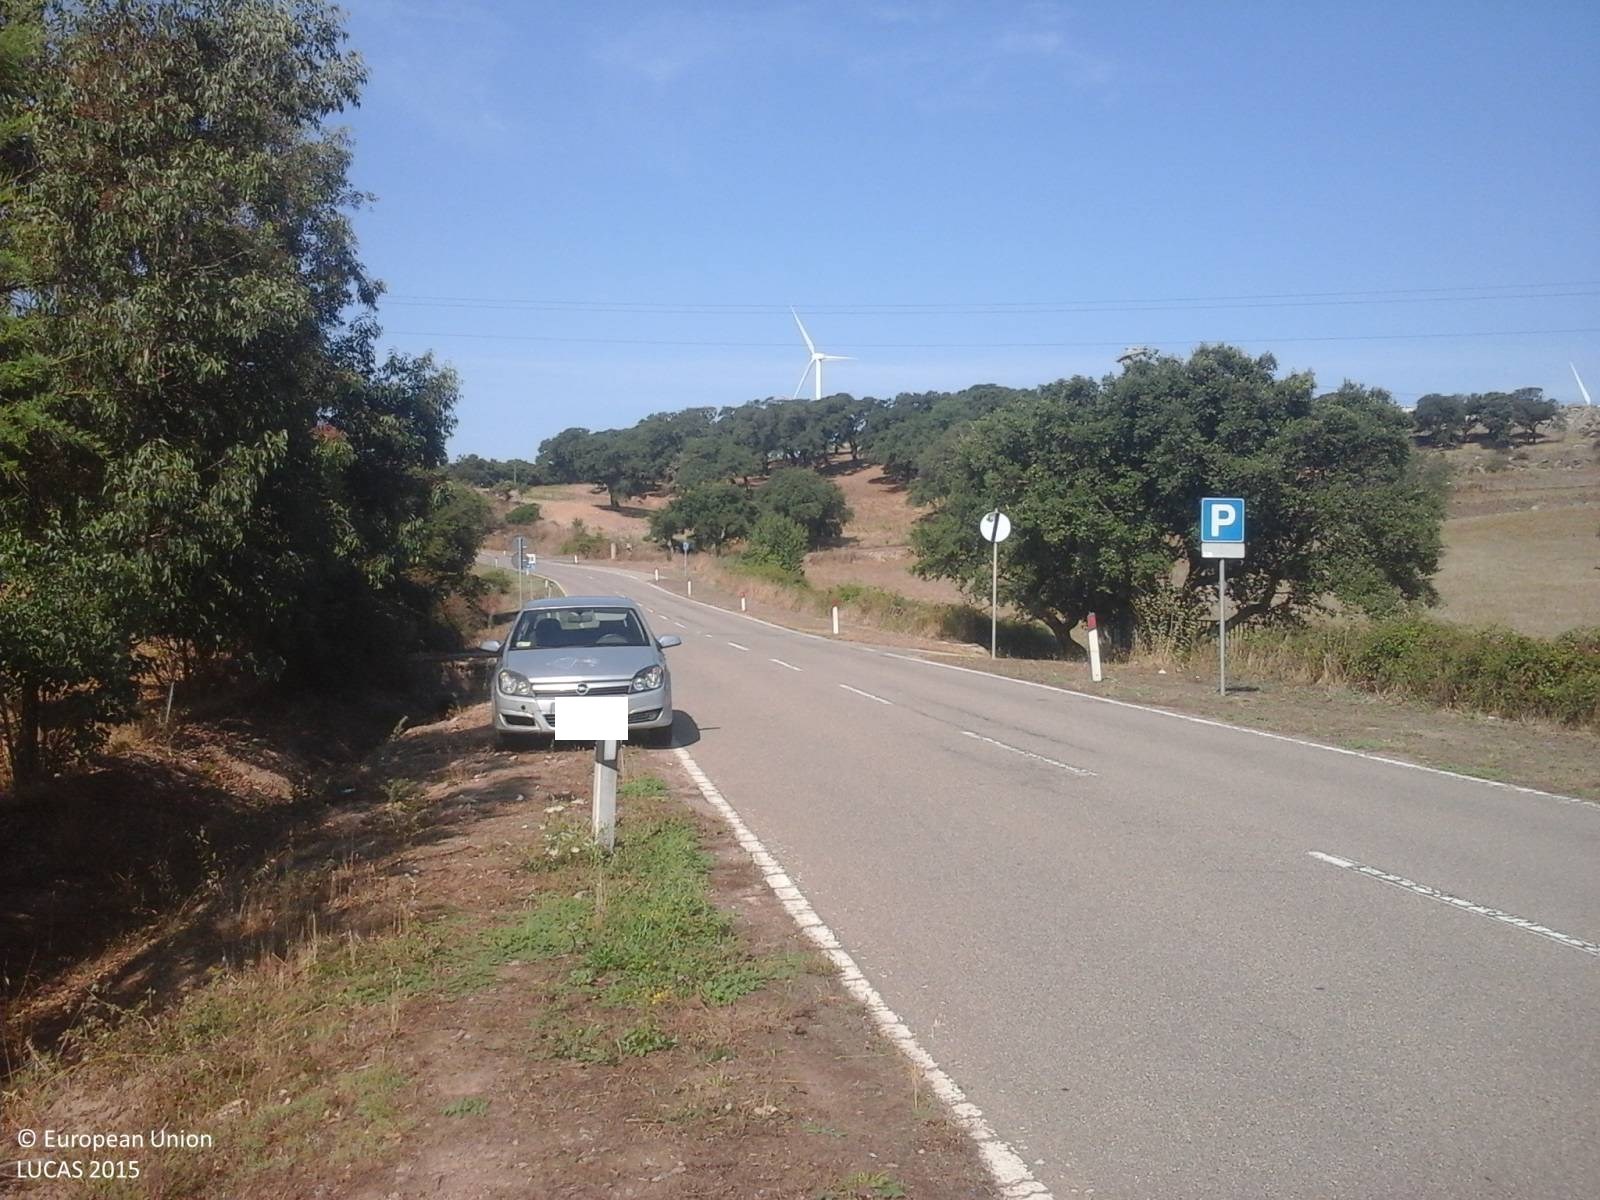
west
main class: Grassland
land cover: Grassland with sparse tree/shrub cover
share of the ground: > 75 %
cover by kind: herbaceous plants 85 %, unconsolidated bare surface 10 %, broadleaved forest trees 5 %
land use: Agriculture (excluding fallow land and kitchen gardens)
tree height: < 5 m
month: August
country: IT
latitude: 39.5401
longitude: 9.2481
